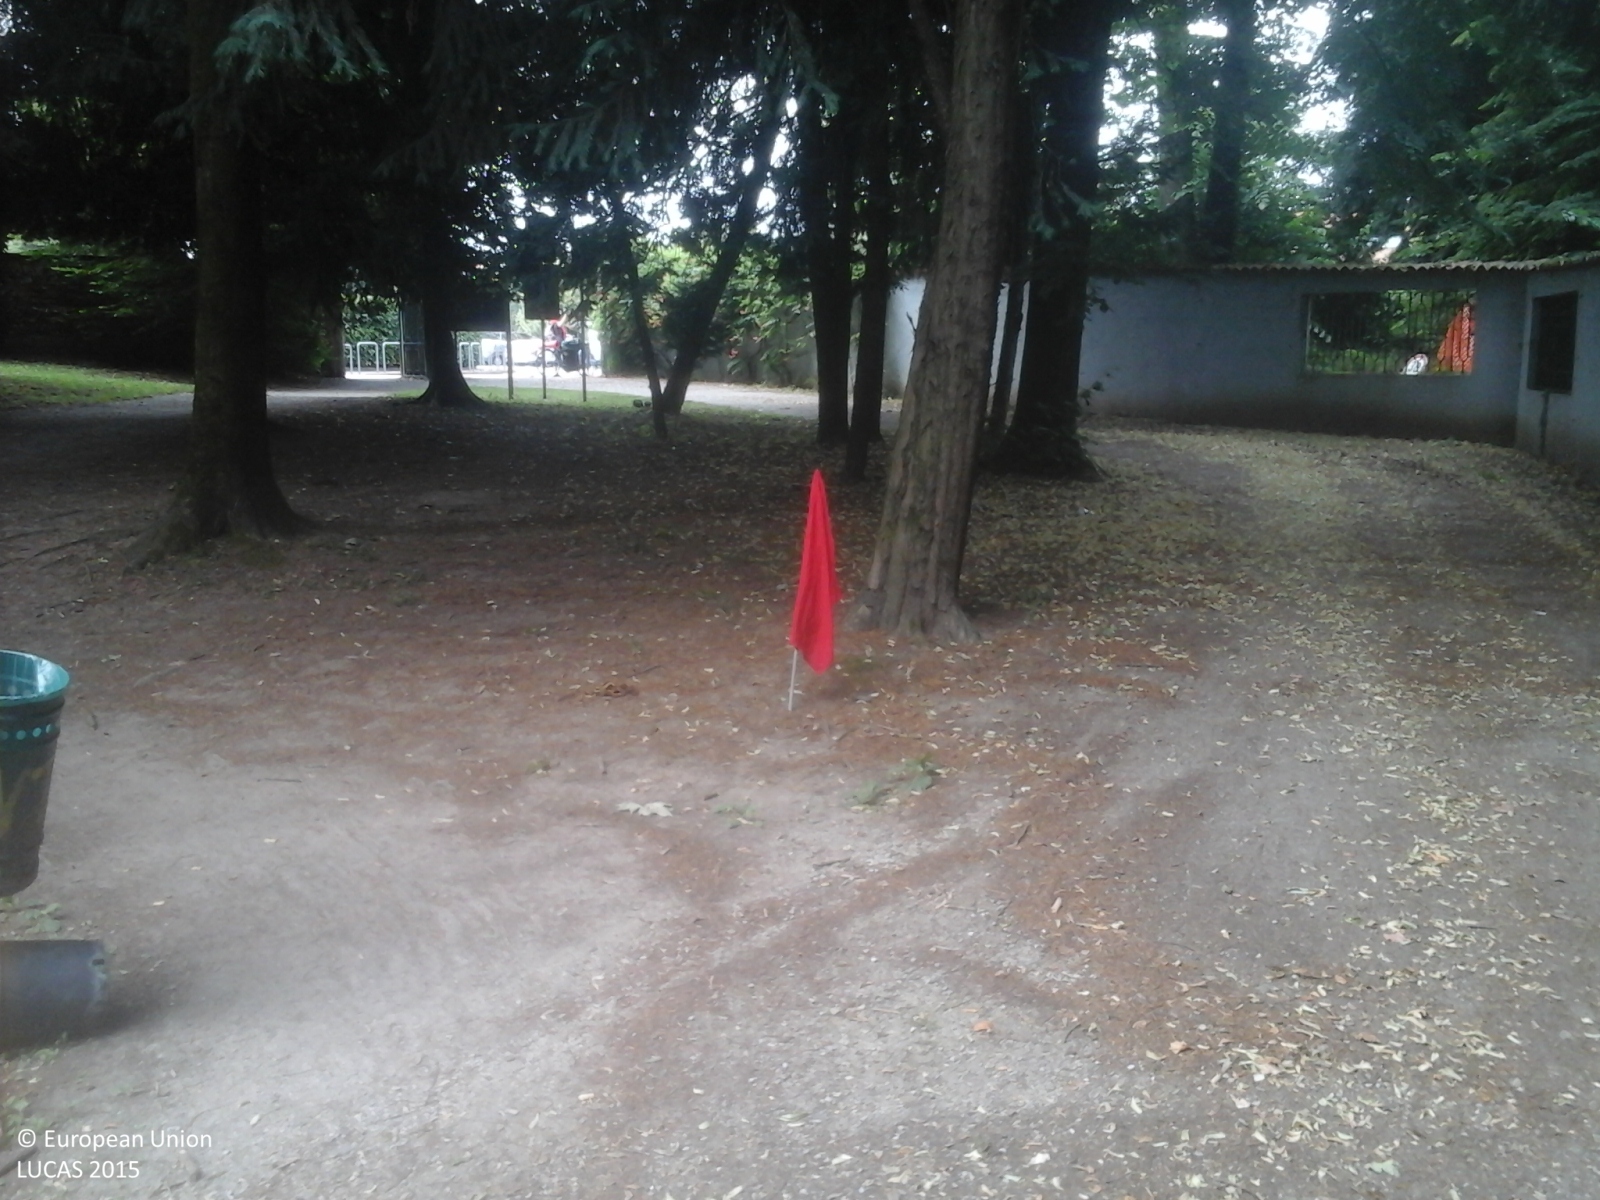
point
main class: Woodland
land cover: Other mixed woodland
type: coniferous forest of the mediterranean region
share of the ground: > 75 %
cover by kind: coniferous forest trees 55 %, broadleaved forest trees 45 %
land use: Amenities, museums, leisure
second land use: Sport
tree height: > 5 m
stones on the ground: 25 - 50 %
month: June
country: IT
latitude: 45.6107
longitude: 9.3727
